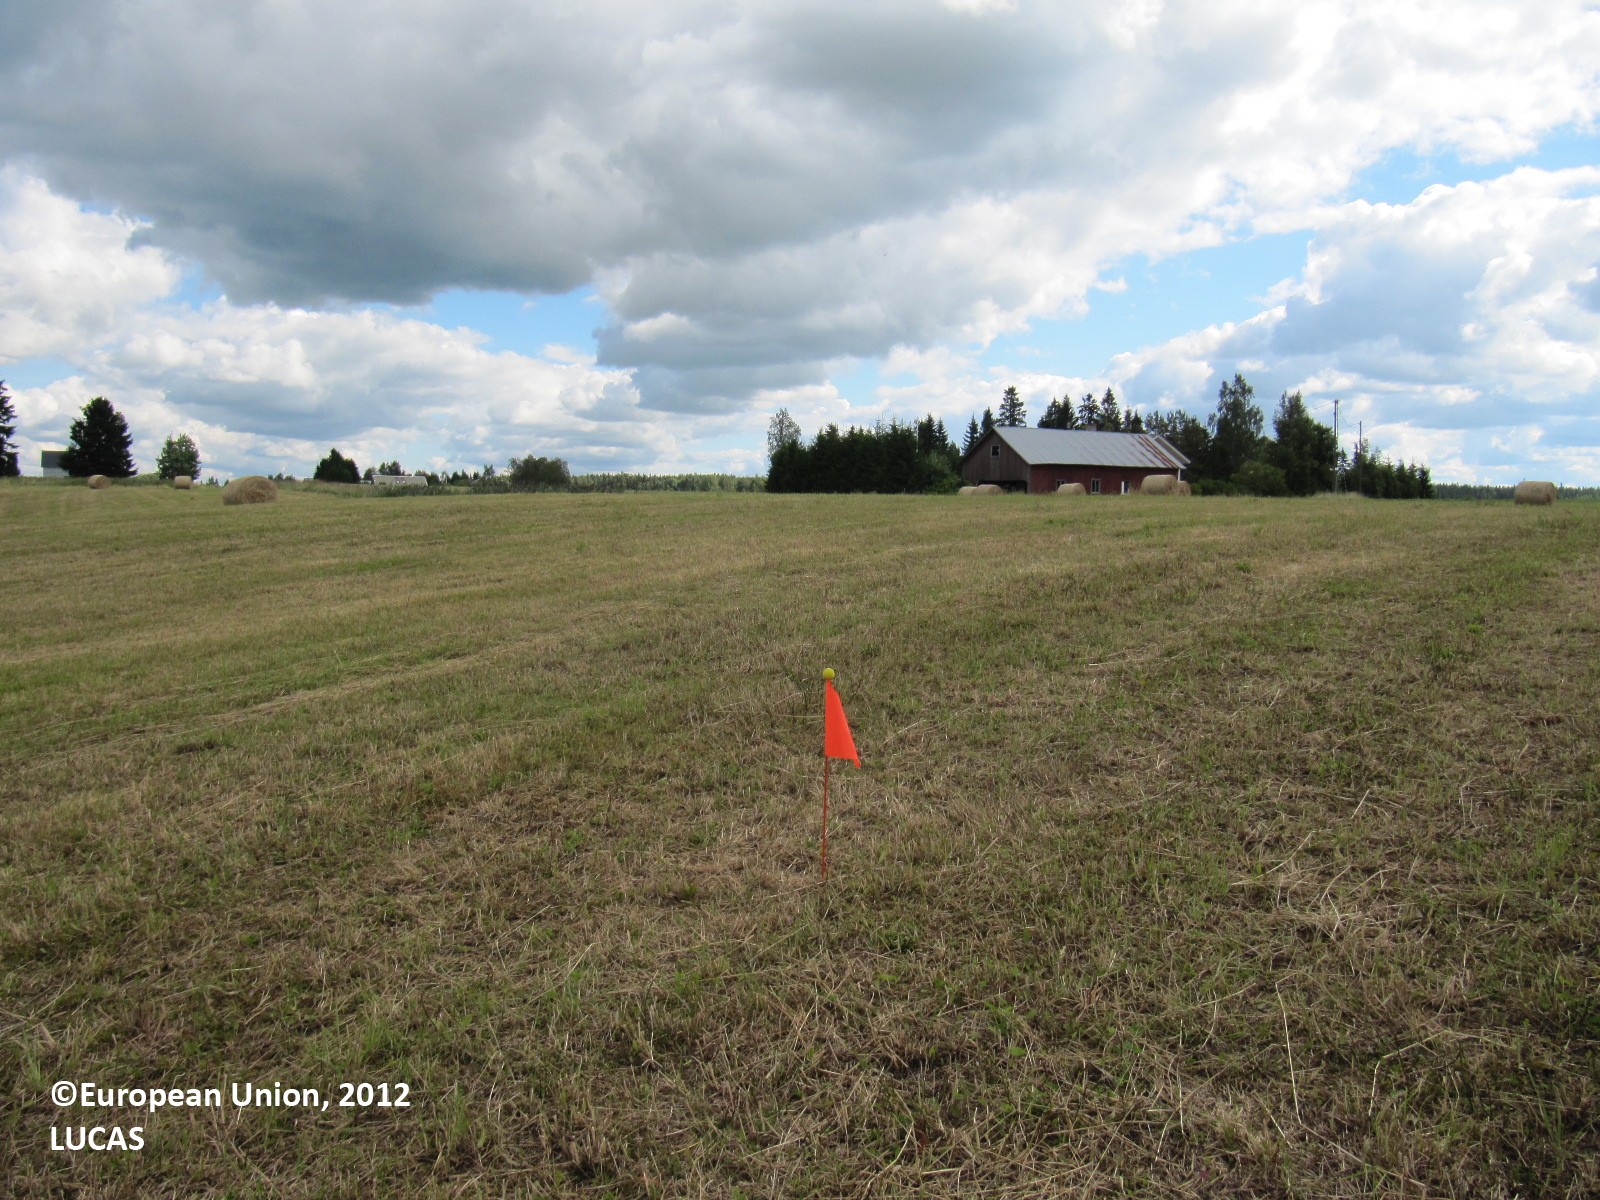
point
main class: Grassland
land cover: Grassland without tree/shrub cover
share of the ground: > 75 %
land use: Agriculture (excluding fallow land and kitchen gardens)
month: August
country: FI
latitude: 60.5389
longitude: 23.2606
